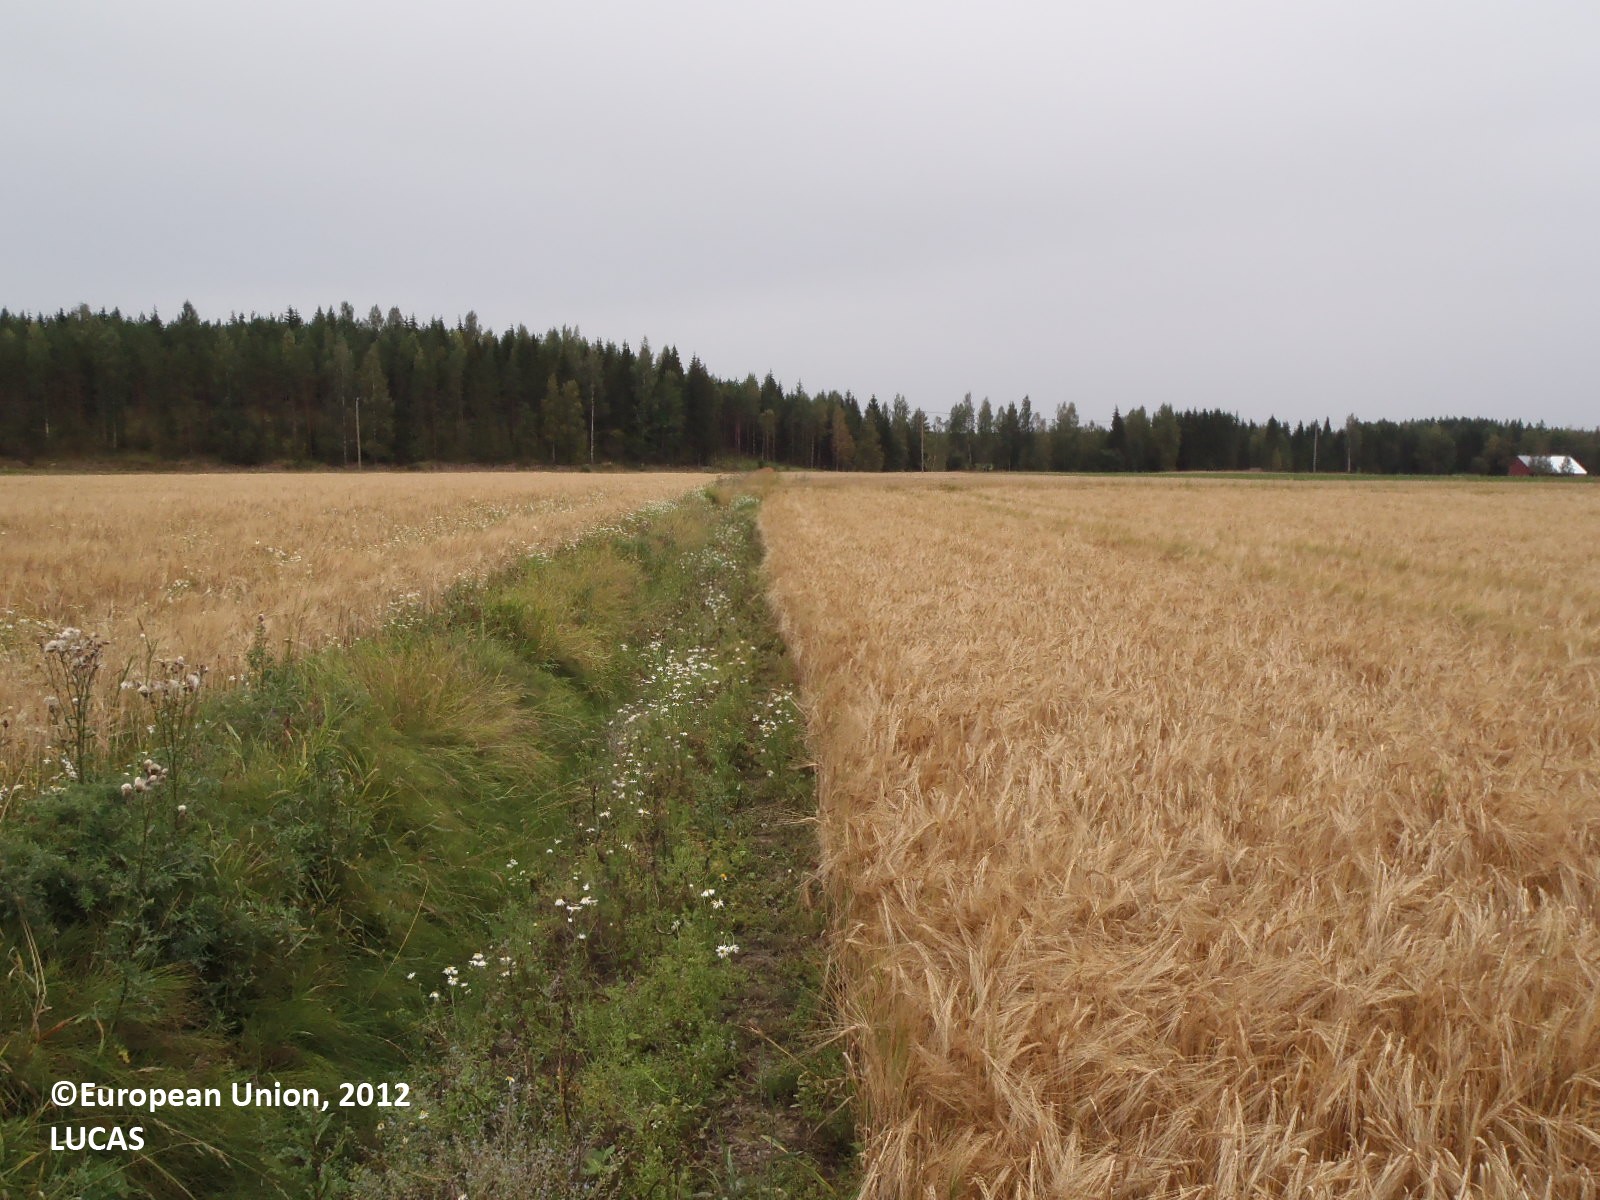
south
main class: Cropland
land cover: Barley
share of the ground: > 75 %
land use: Agriculture (excluding fallow land and kitchen gardens)
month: August
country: FI
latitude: 60.8194
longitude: 22.5908
